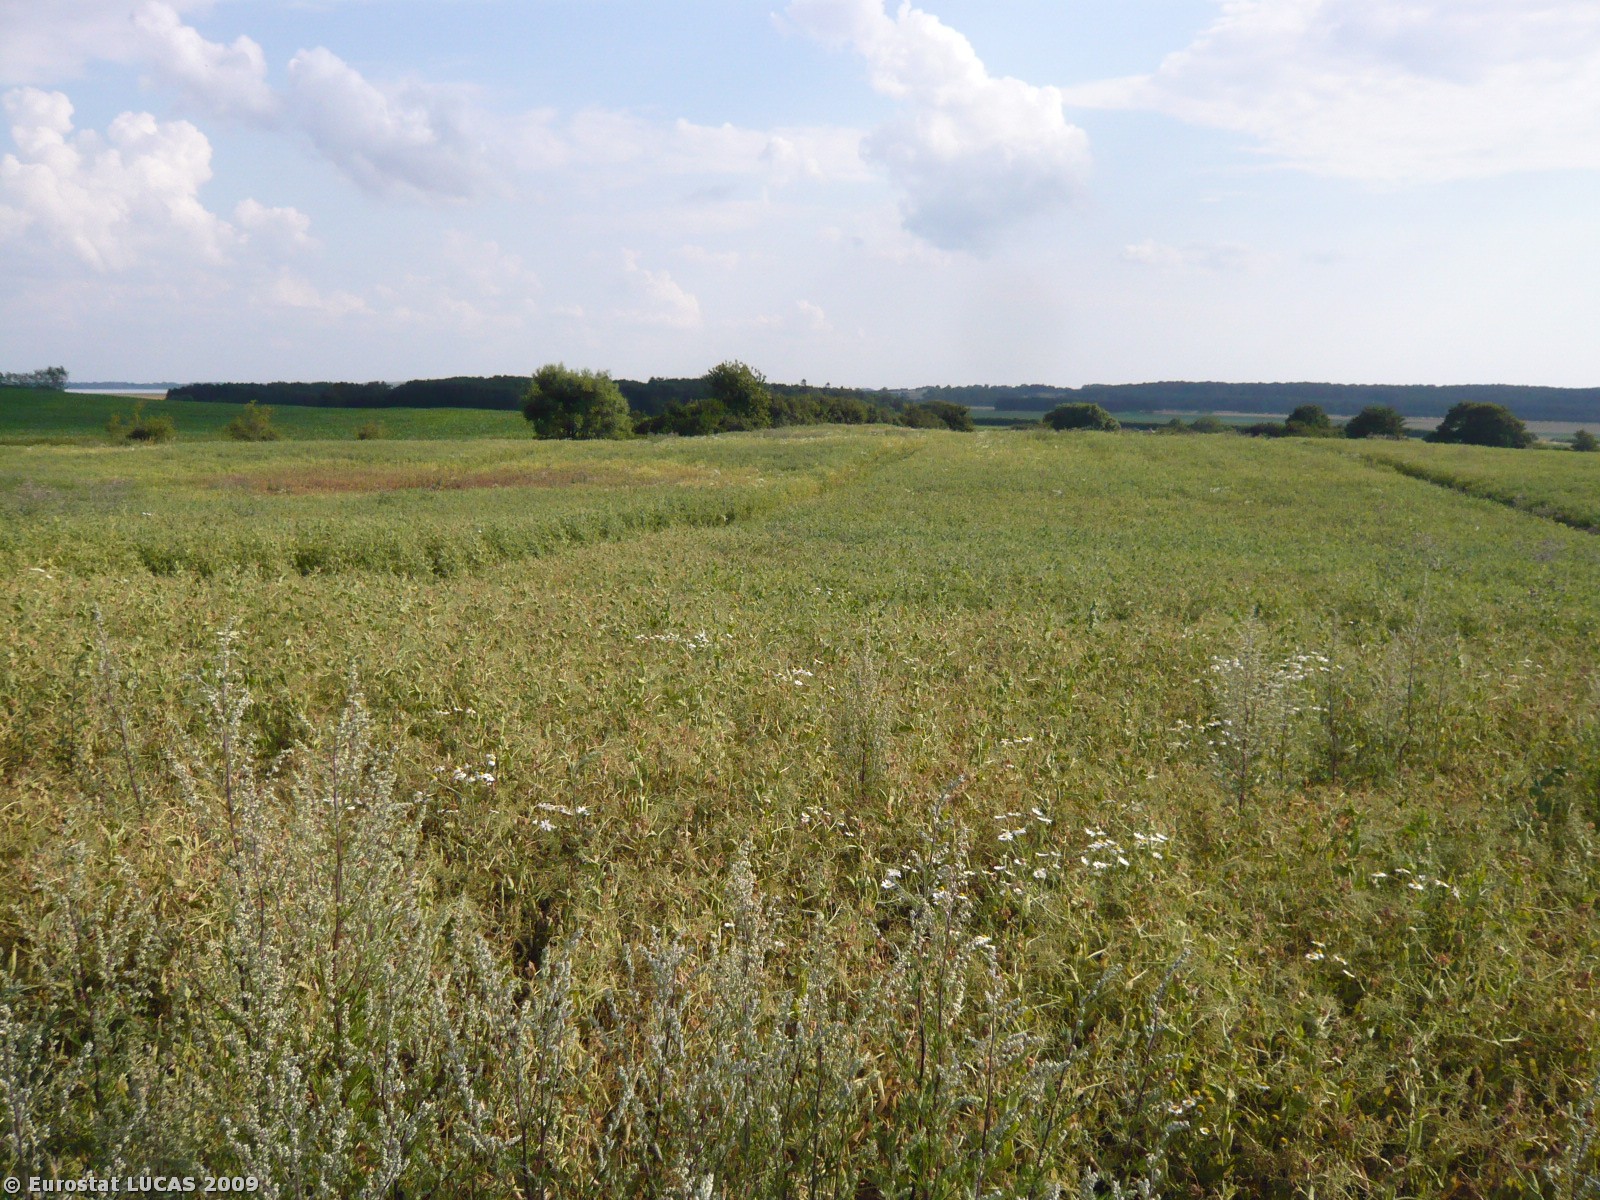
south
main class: Cropland
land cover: Dry pulses
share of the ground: > 75 %
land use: Agriculture (excluding fallow land and kitchen gardens)
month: July
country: DK
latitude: 55.8356
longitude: 11.6430
